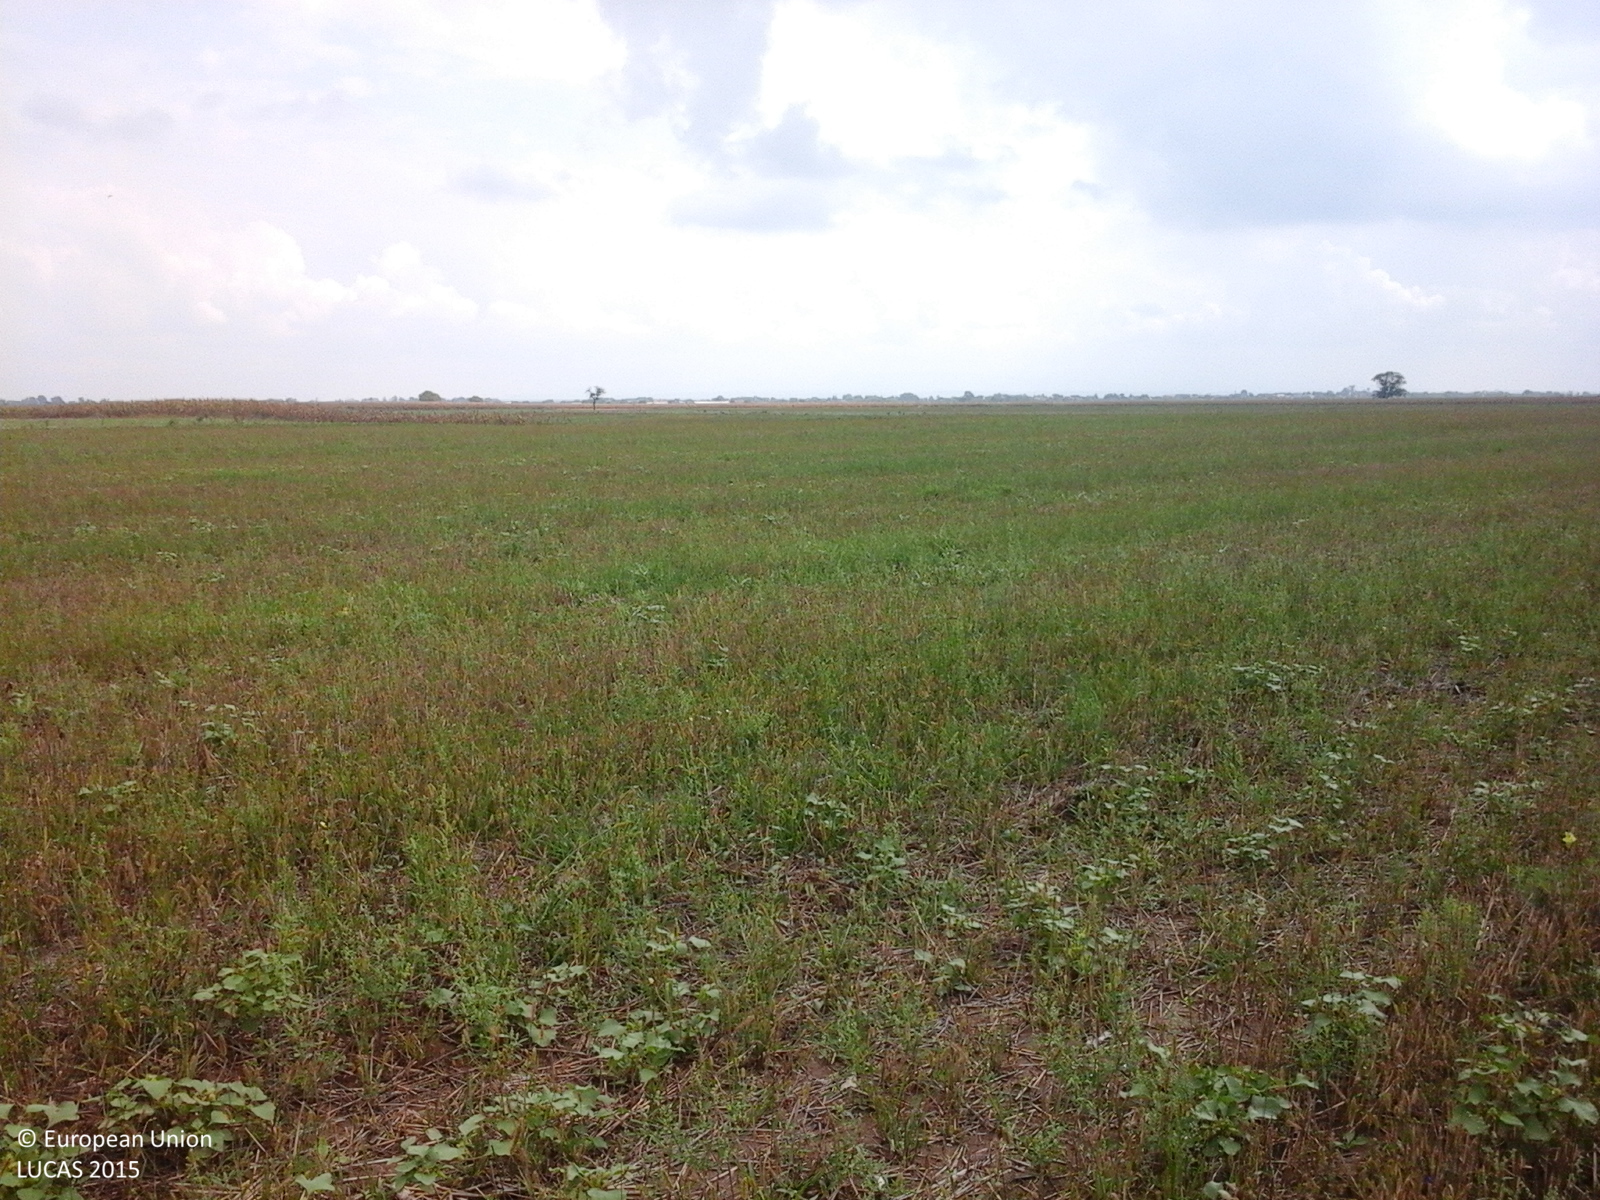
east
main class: Cropland
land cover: Maize
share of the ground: > 75 %
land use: Agriculture (excluding fallow land and kitchen gardens)
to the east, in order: Maize; Grassland without tree/shrub cover; Common wheat
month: September
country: RO
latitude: 46.7317
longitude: 21.8072
